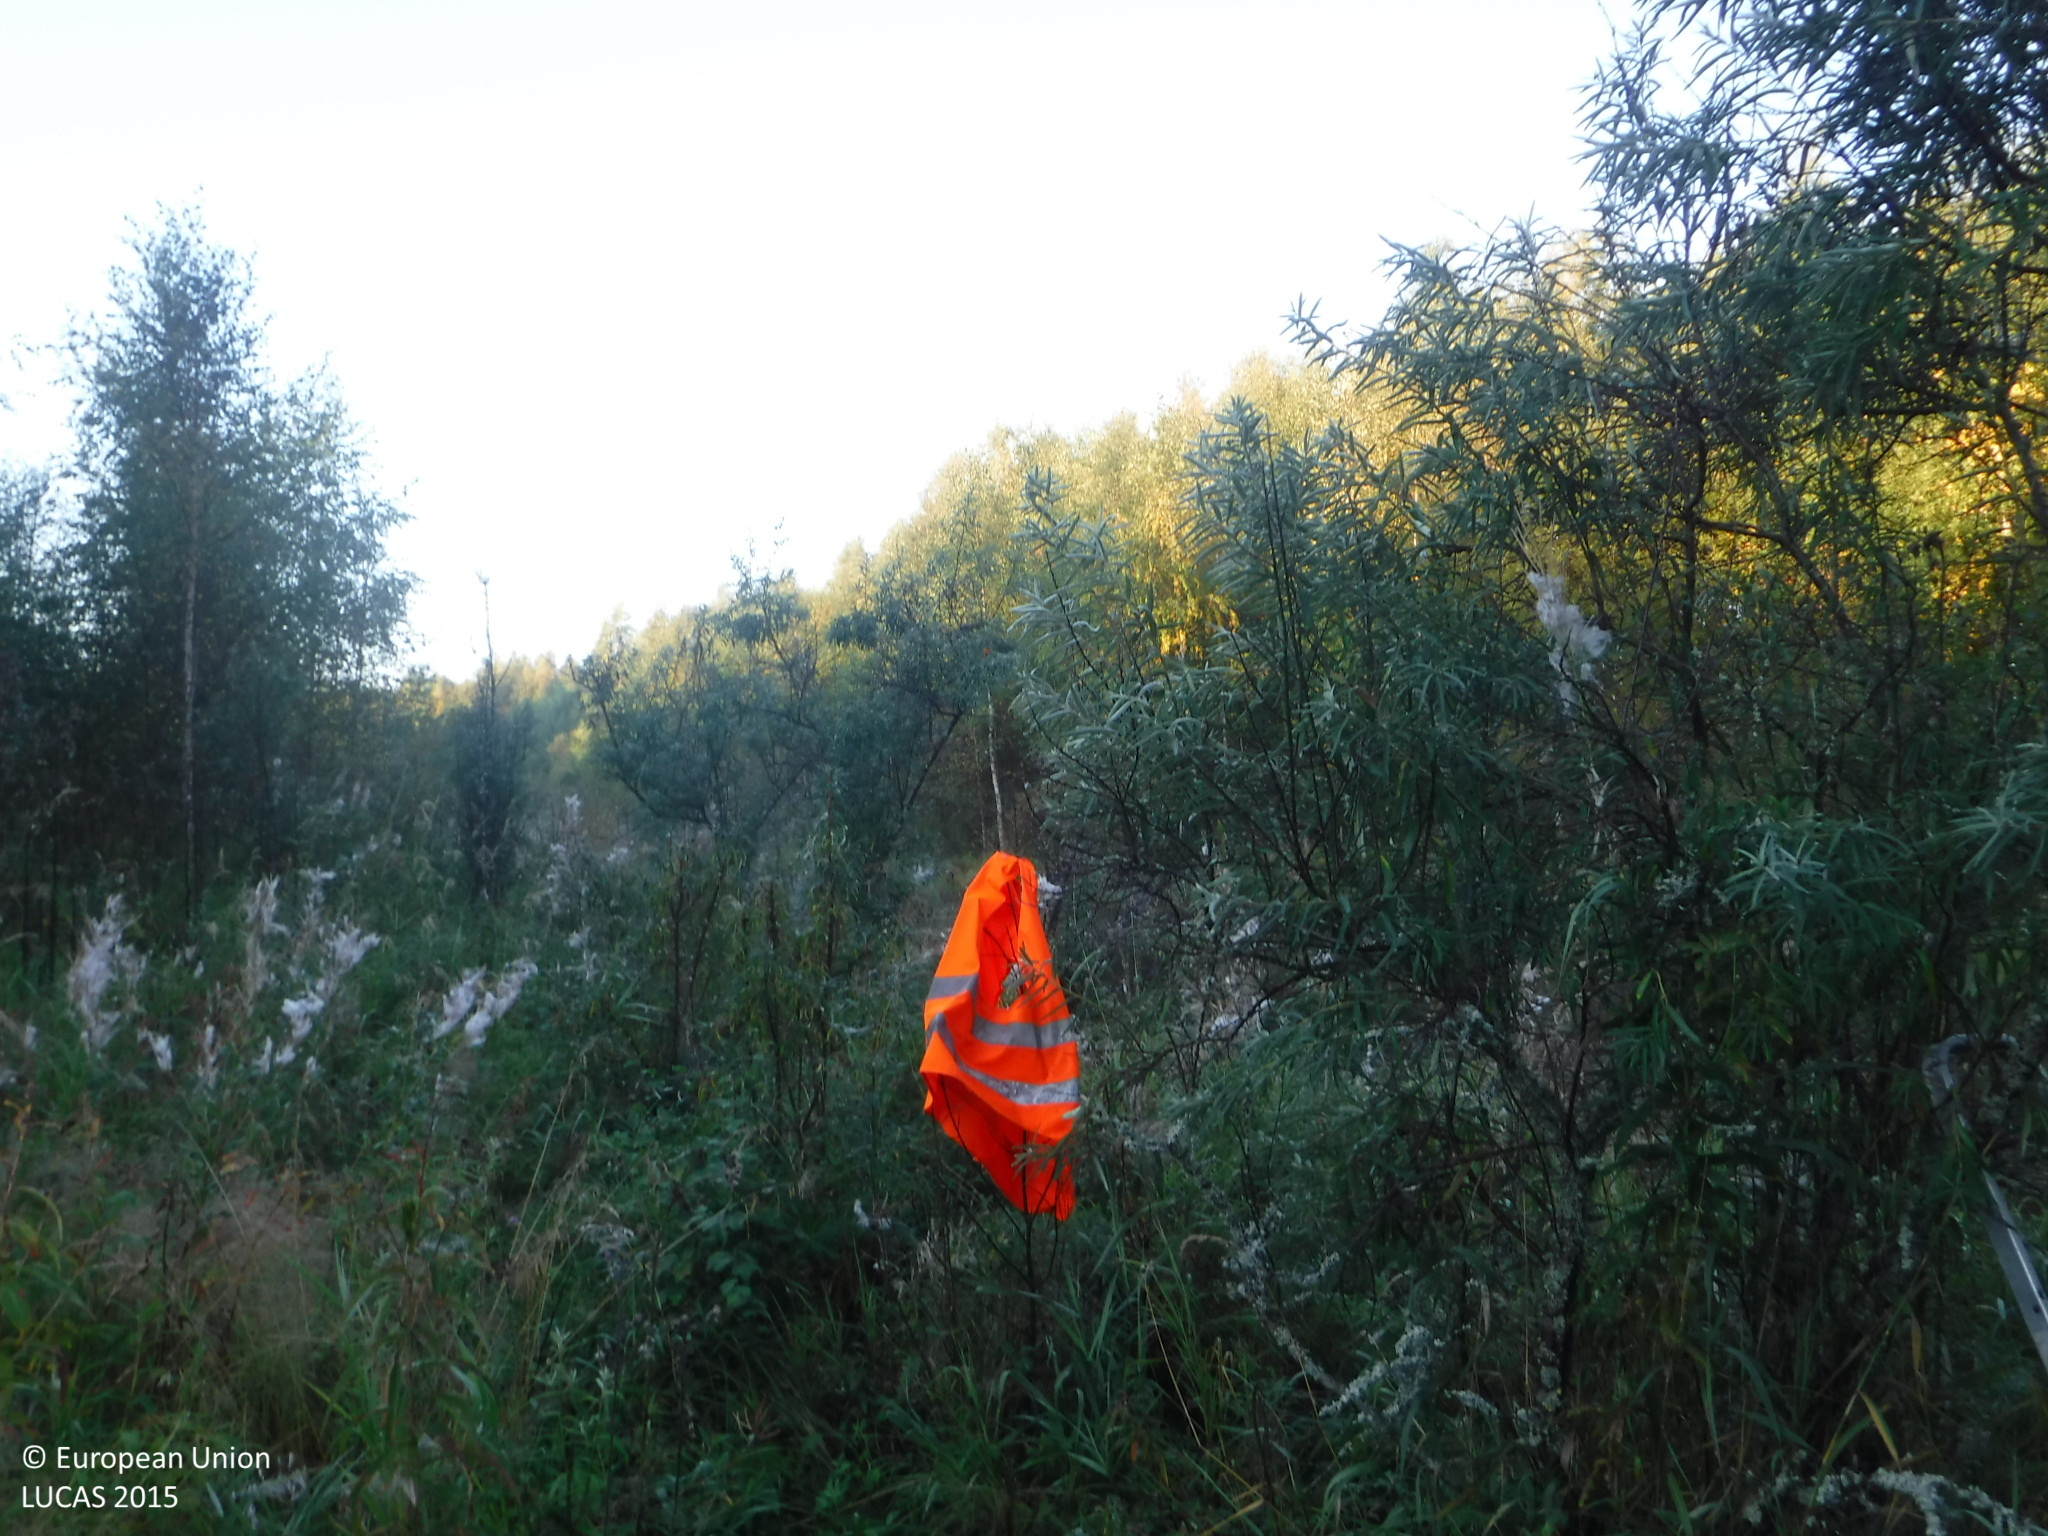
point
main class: Woodland
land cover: Broadleaved woodland
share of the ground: 25 - 50 %
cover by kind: broadleaved forest trees 35 %, herbaceous plants 35 %, shrubs 30 %
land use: Abandoned areas
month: September
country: FI
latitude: 61.7104
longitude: 22.2200
